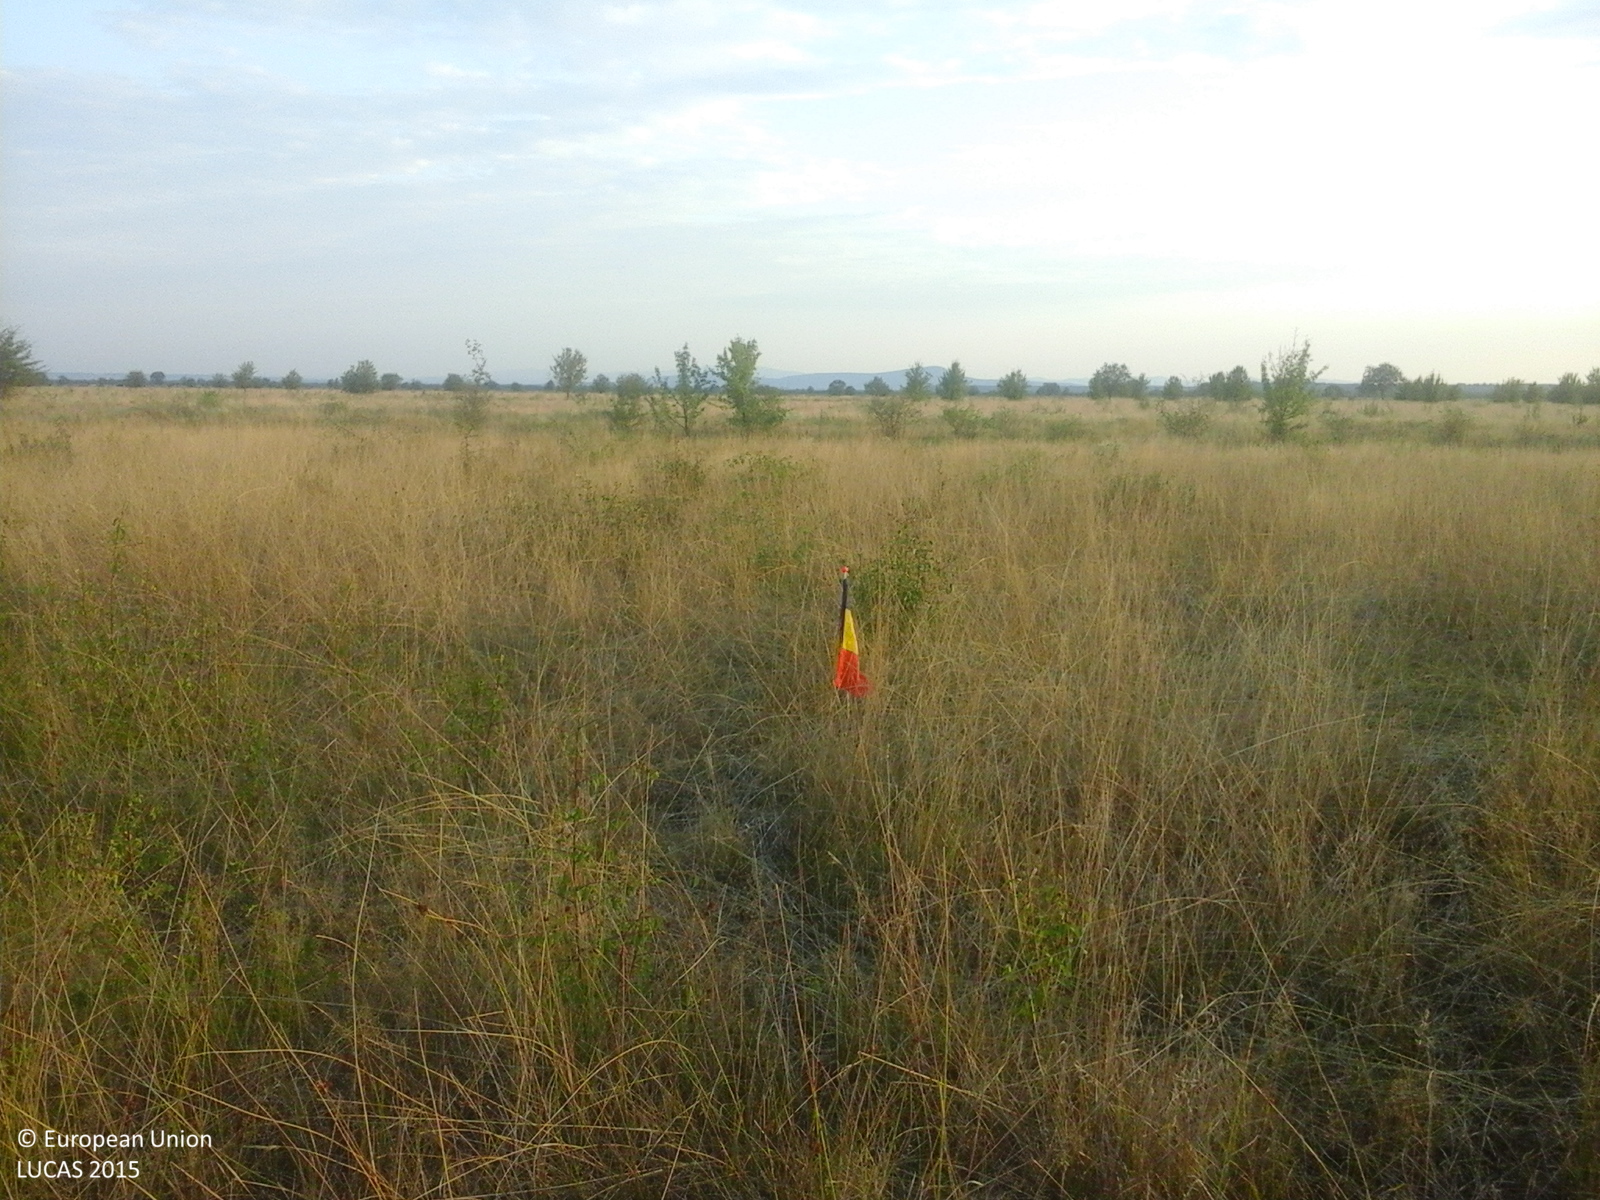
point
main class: Grassland
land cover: Grassland with sparse tree/shrub cover
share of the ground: > 75 %
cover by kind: herbaceous plants 85 %, shrubs 10 %, broadleaved forest trees 5 %
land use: Agriculture (excluding fallow land and kitchen gardens)
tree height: < 5 m
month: August
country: RO
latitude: 46.5193
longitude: 21.9181
